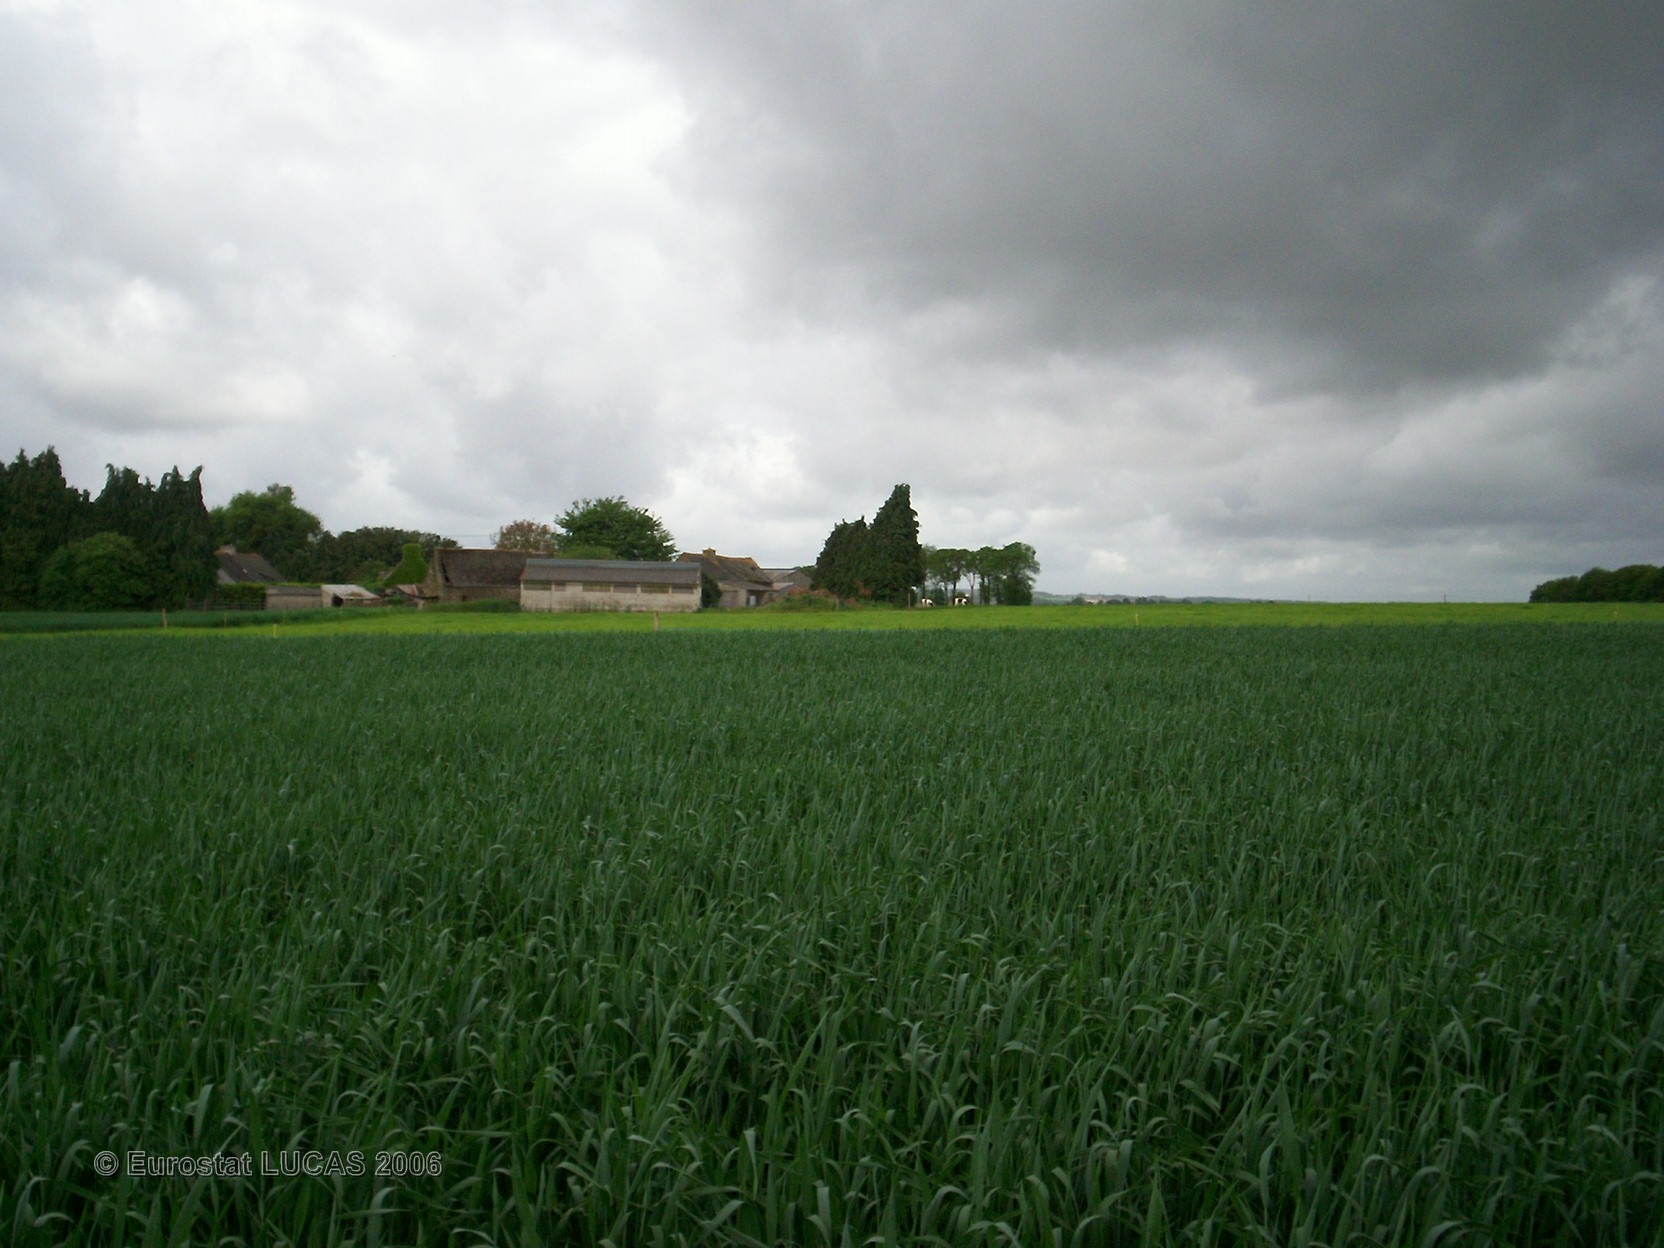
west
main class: Cropland
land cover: Common wheat
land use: Agriculture (excluding fallow land and kitchen gardens)
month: May
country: FR
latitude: 47.9352
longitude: -2.9028
